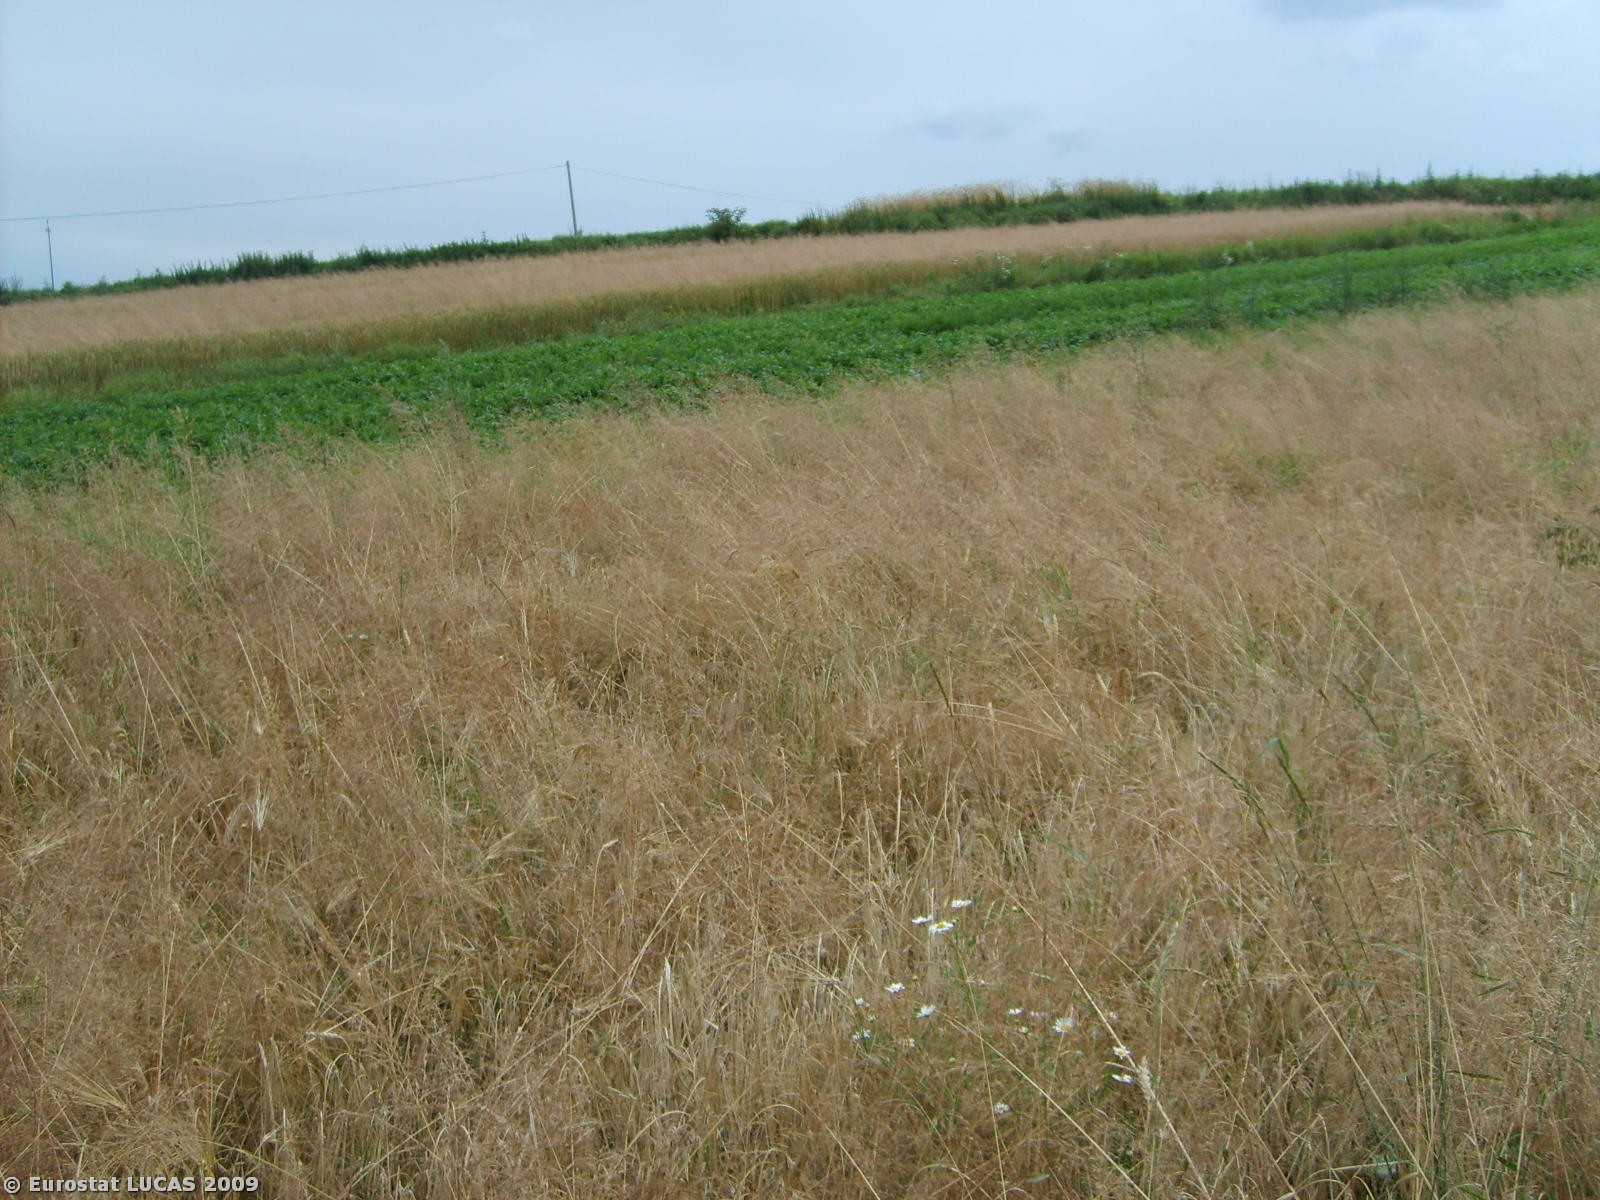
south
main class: Cropland
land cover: Barley
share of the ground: > 75 %
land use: Agriculture (excluding fallow land and kitchen gardens)
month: July
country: PL
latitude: 50.3169
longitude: 20.6711
